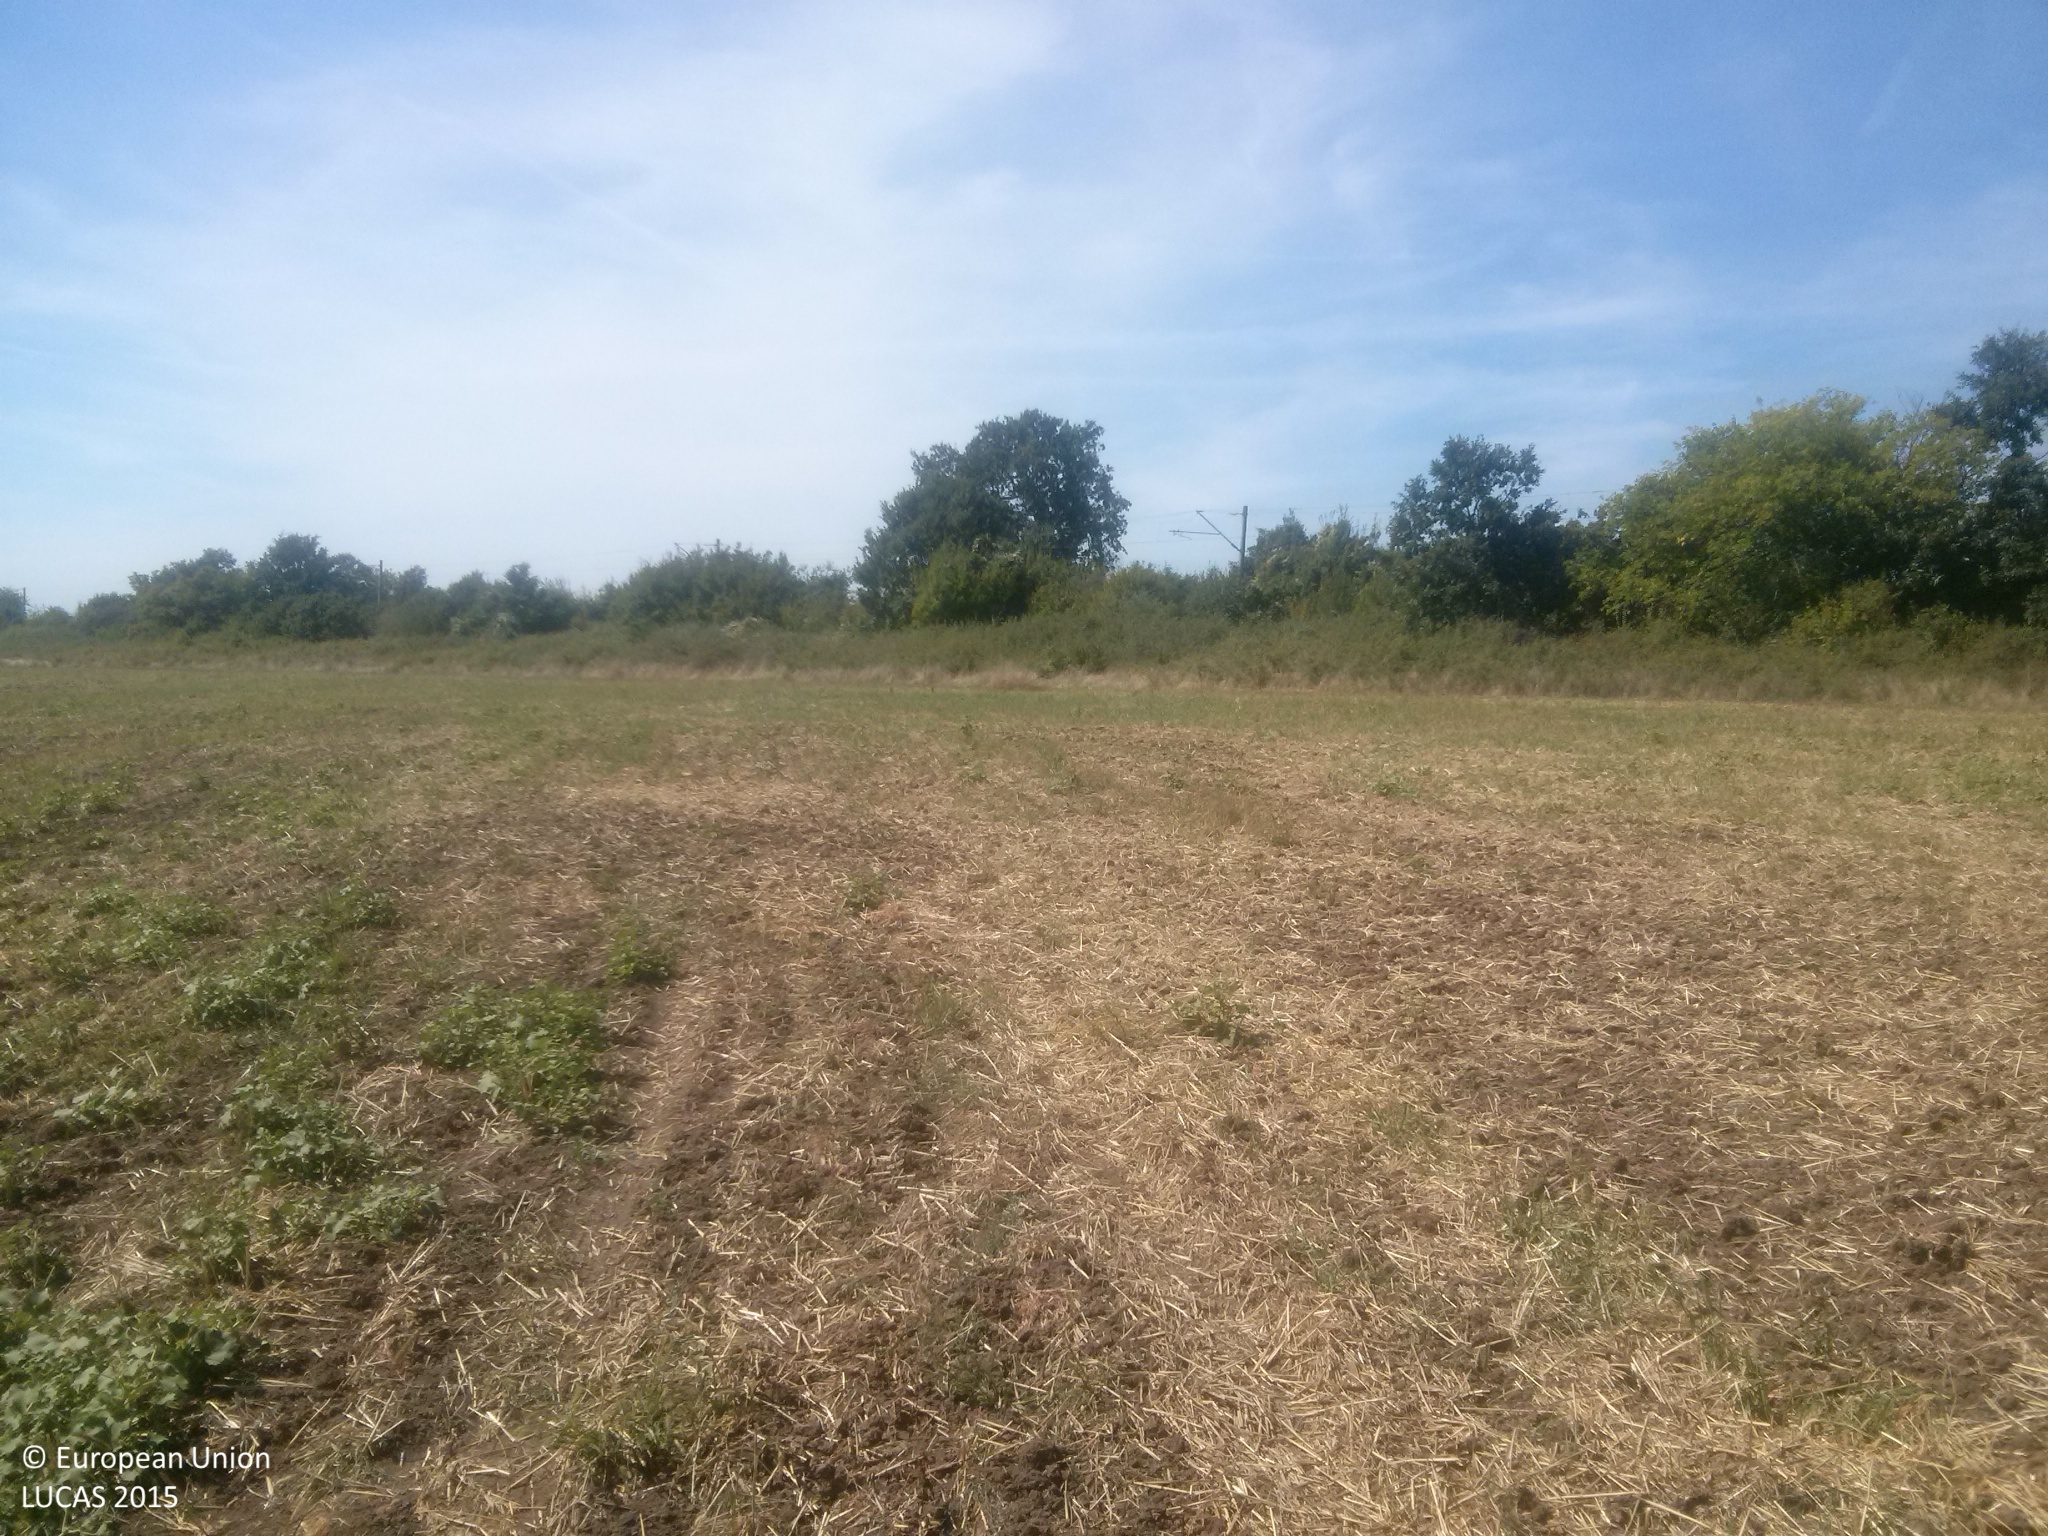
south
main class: Cropland
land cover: Common wheat
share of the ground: 10 - 25 %
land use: Agriculture (excluding fallow land and kitchen gardens)
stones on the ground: < 10 %
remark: Tilled/Sowed
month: September
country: BG
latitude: 43.6914
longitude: 26.3180
